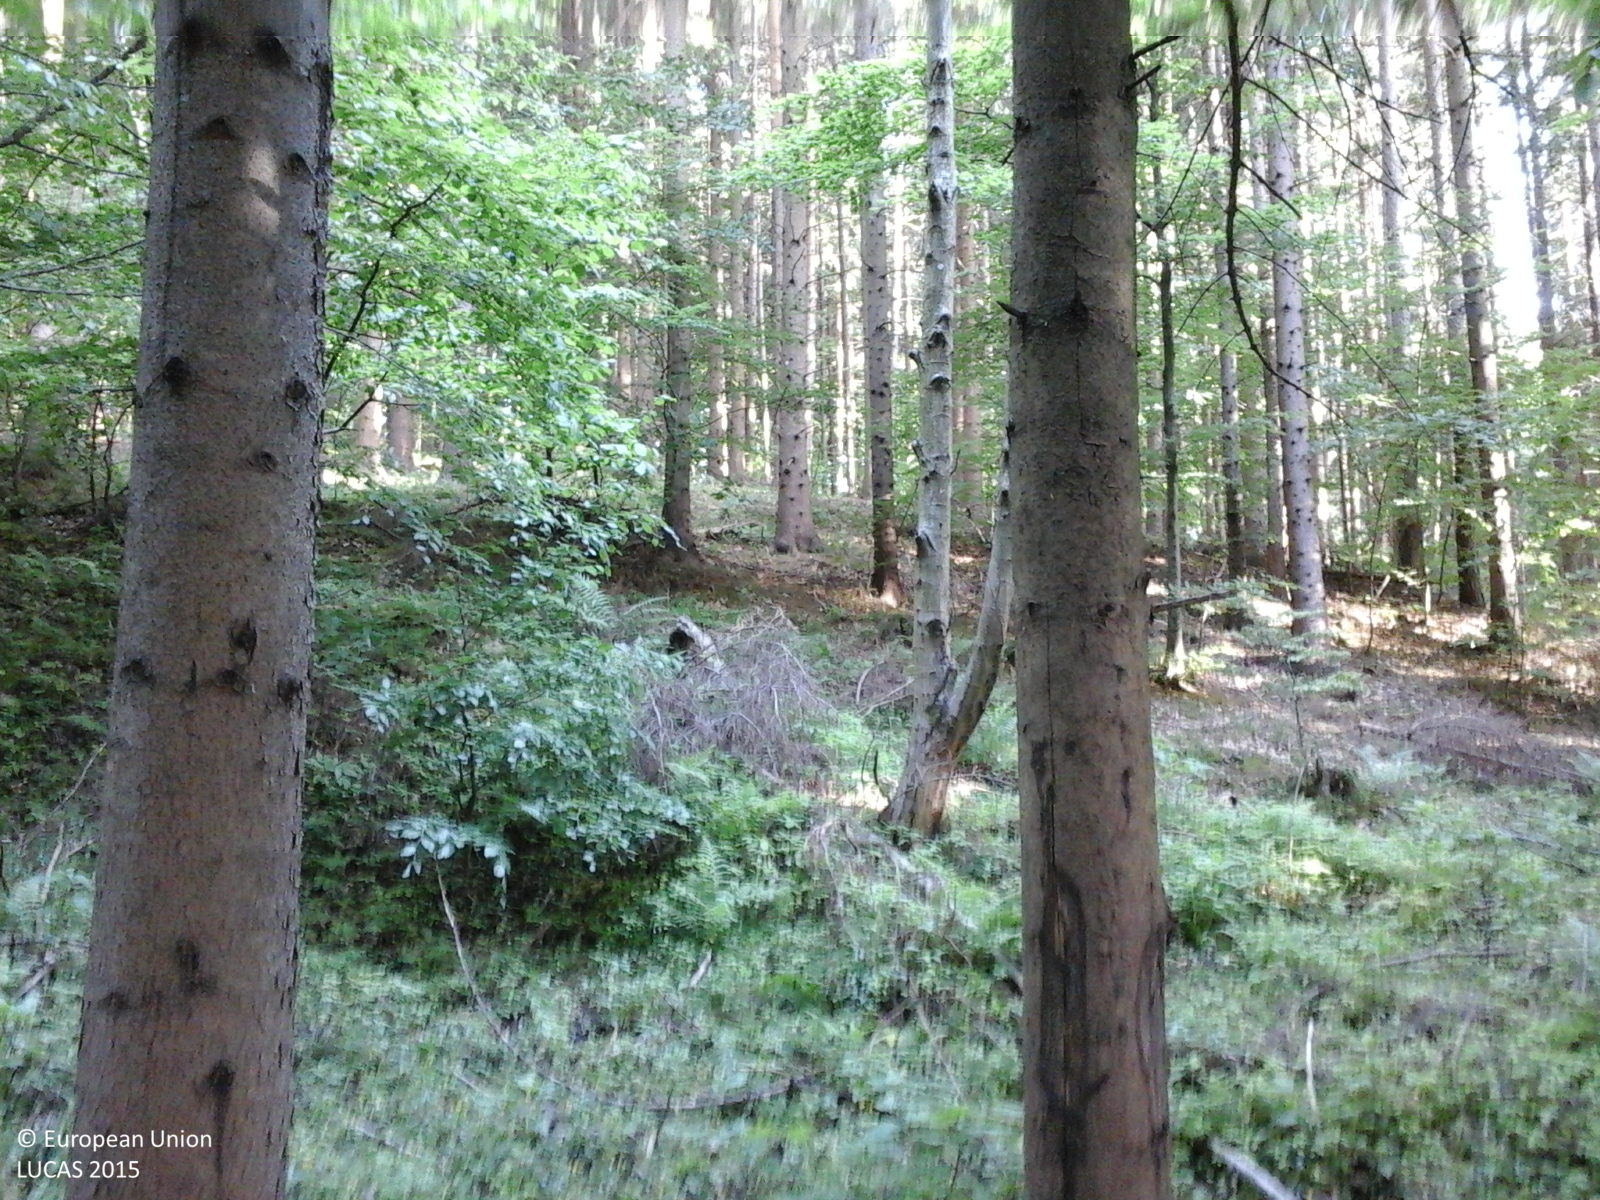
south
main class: Woodland
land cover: Spruce dominated mixed woodland
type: hemiboreal forest and nemoral coniferous forest and mixed broadleaved-coniferous forest
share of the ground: > 75 %
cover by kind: coniferous forest trees 60 %, broadleaved forest trees 40 %
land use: Forestry
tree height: > 5 m
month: May
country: RO
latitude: 45.2664
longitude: 25.8732
